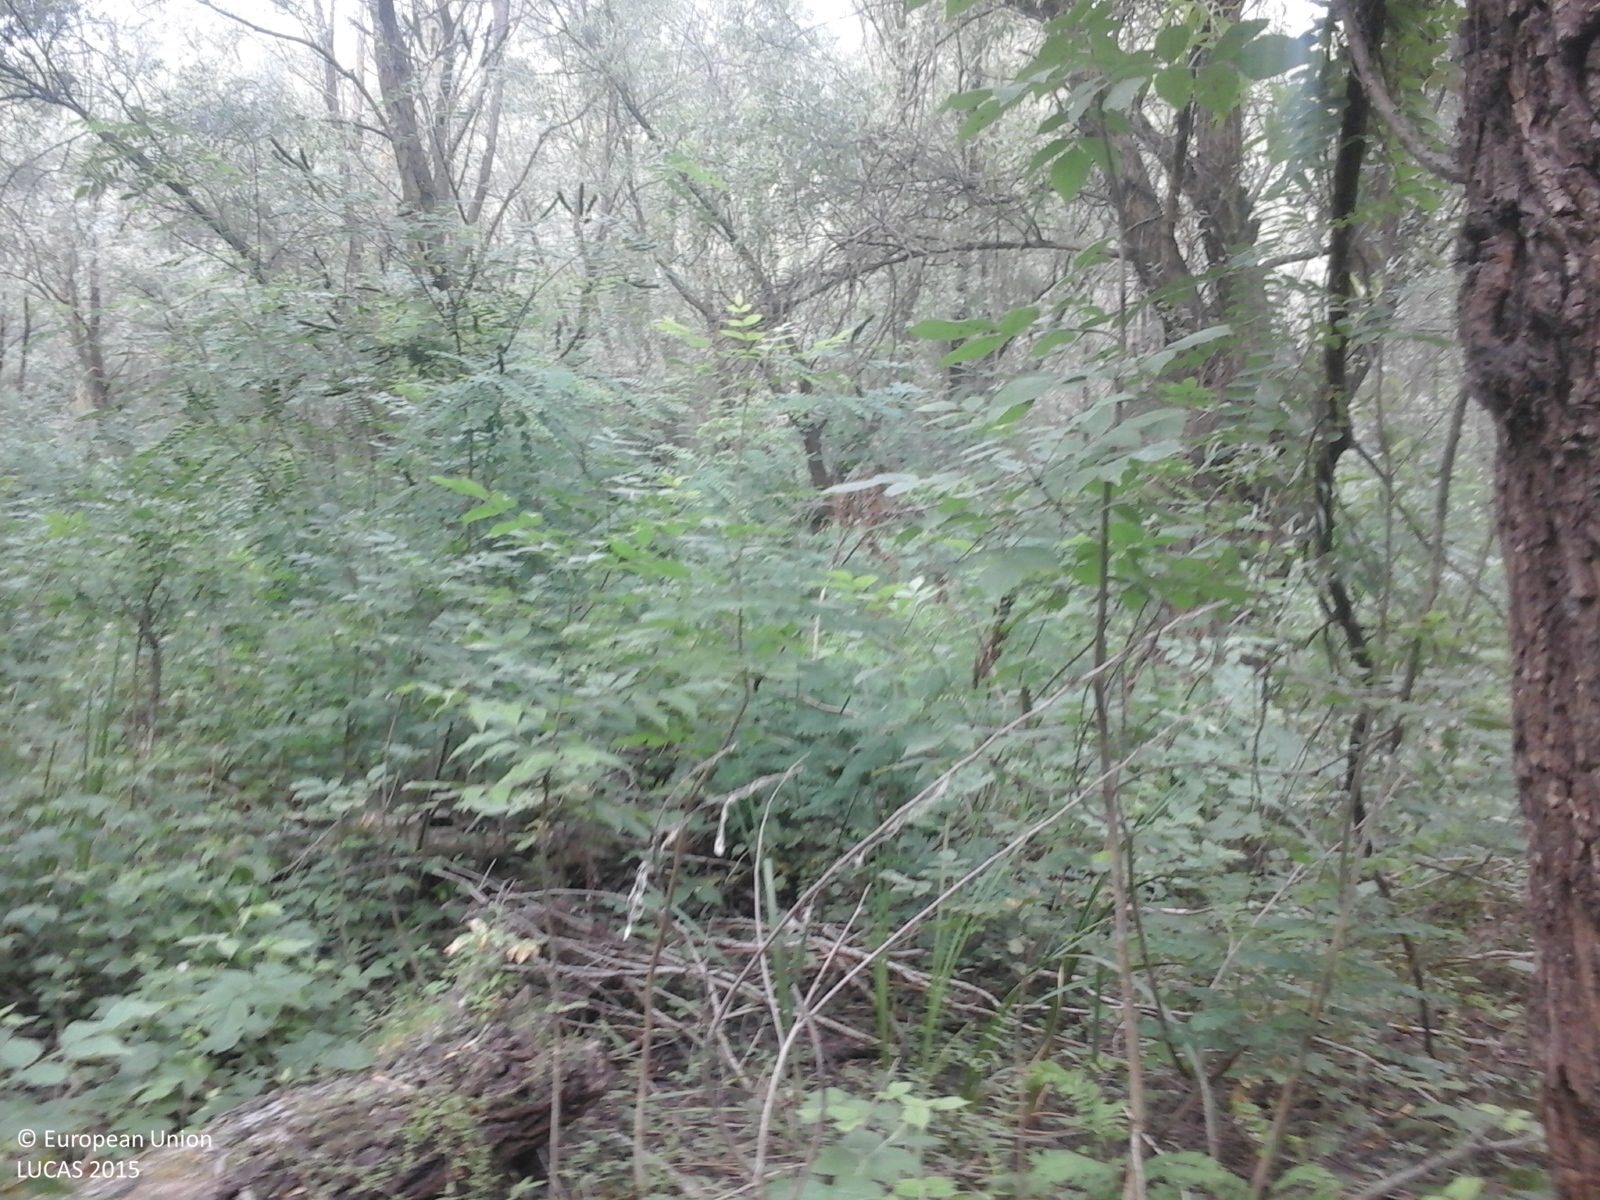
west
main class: Woodland
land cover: Broadleaved woodland
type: floodplain forest
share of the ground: > 75 %
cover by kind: broadleaved forest trees 100 %
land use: Forestry
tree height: > 5 m
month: July
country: RO
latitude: 45.0776
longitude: 28.1437
